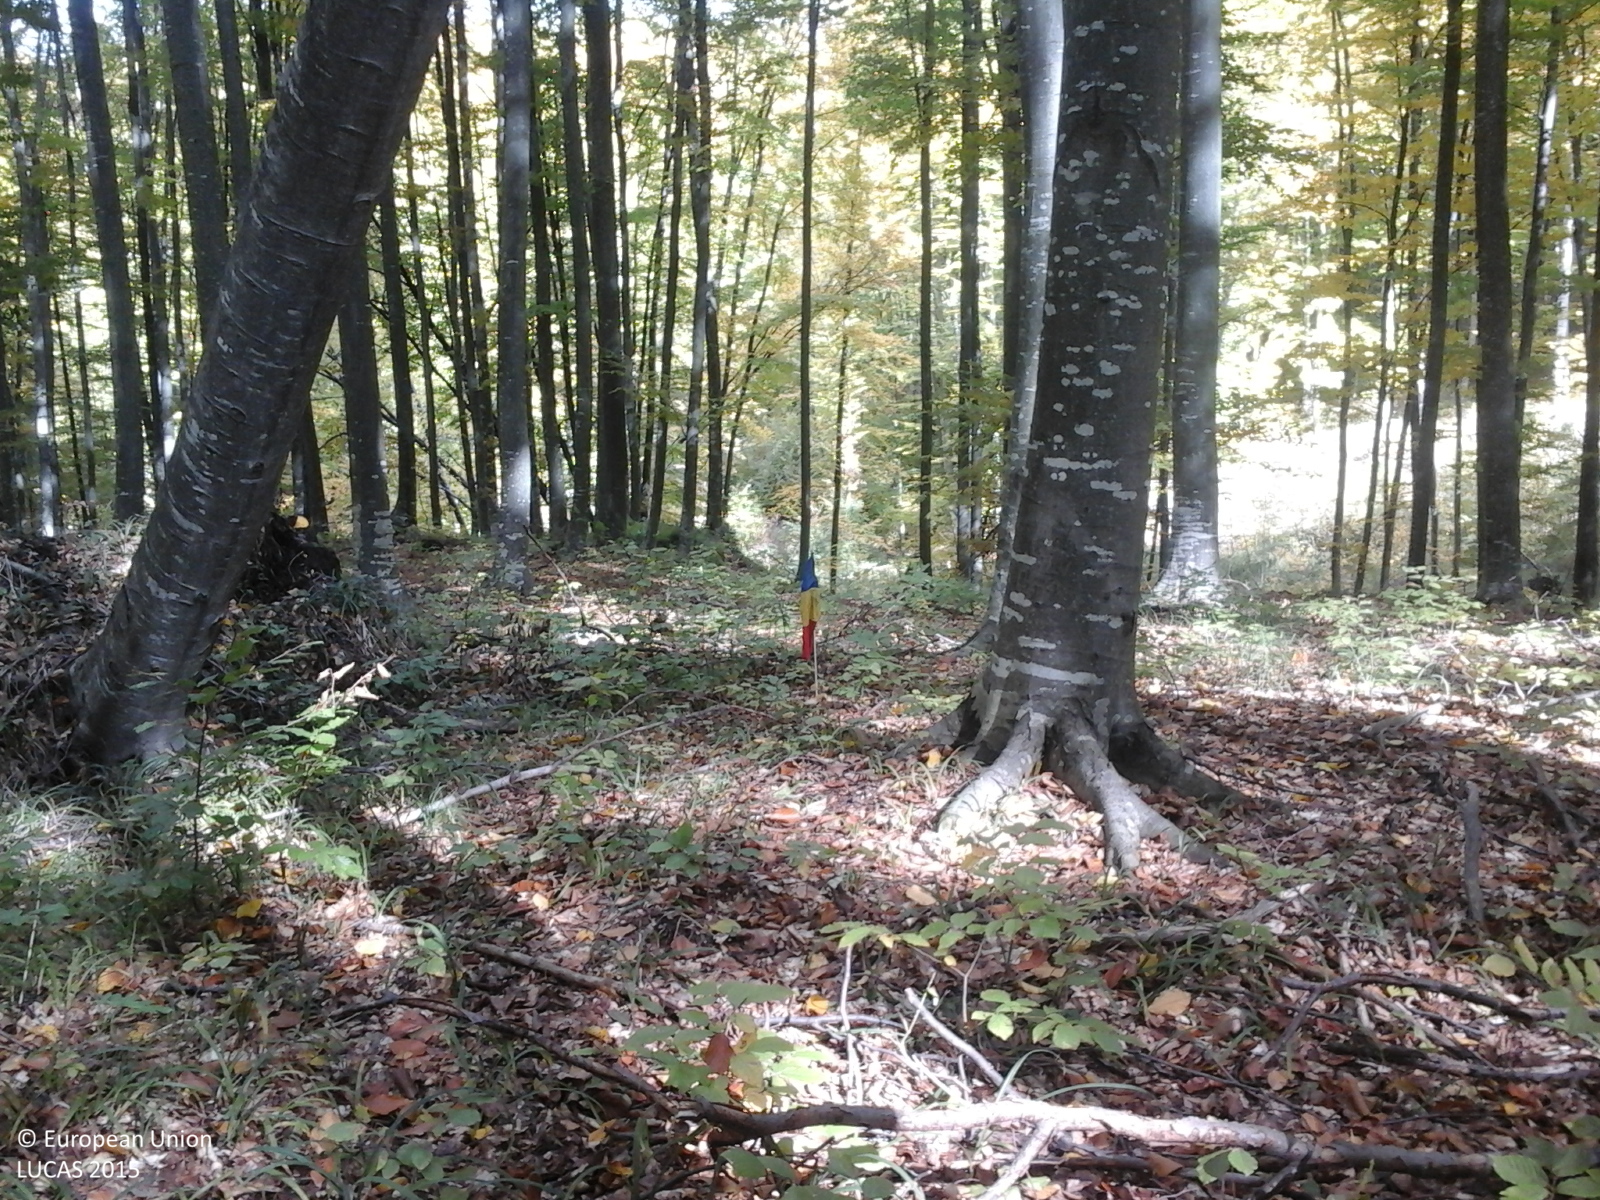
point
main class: Woodland
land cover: Broadleaved woodland
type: mesophytic deciduous forest
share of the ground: > 75 %
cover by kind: broadleaved forest trees 100 %
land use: Forestry
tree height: > 5 m
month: October
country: RO
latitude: 45.1762
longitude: 25.7426
